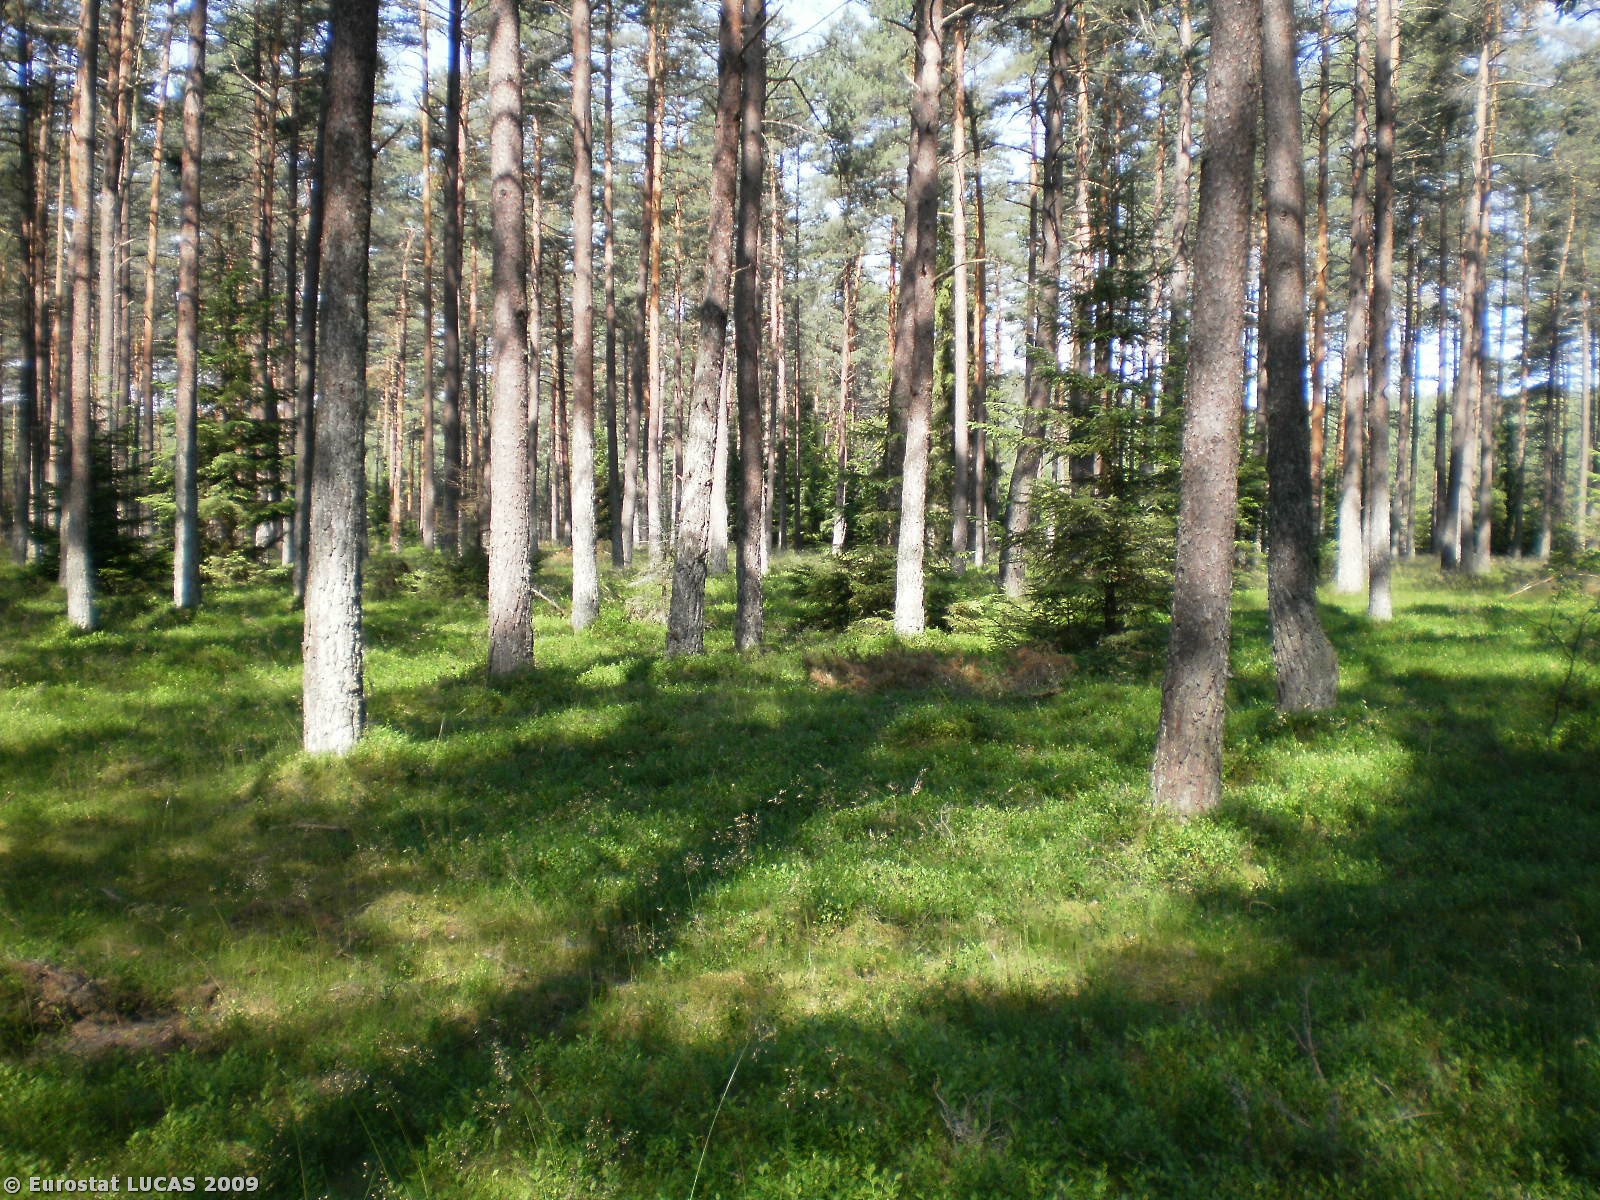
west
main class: Woodland
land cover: Coniferous woodland
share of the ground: > 75 %
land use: Forestry
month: July
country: PL
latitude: 54.2663
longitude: 17.2719
